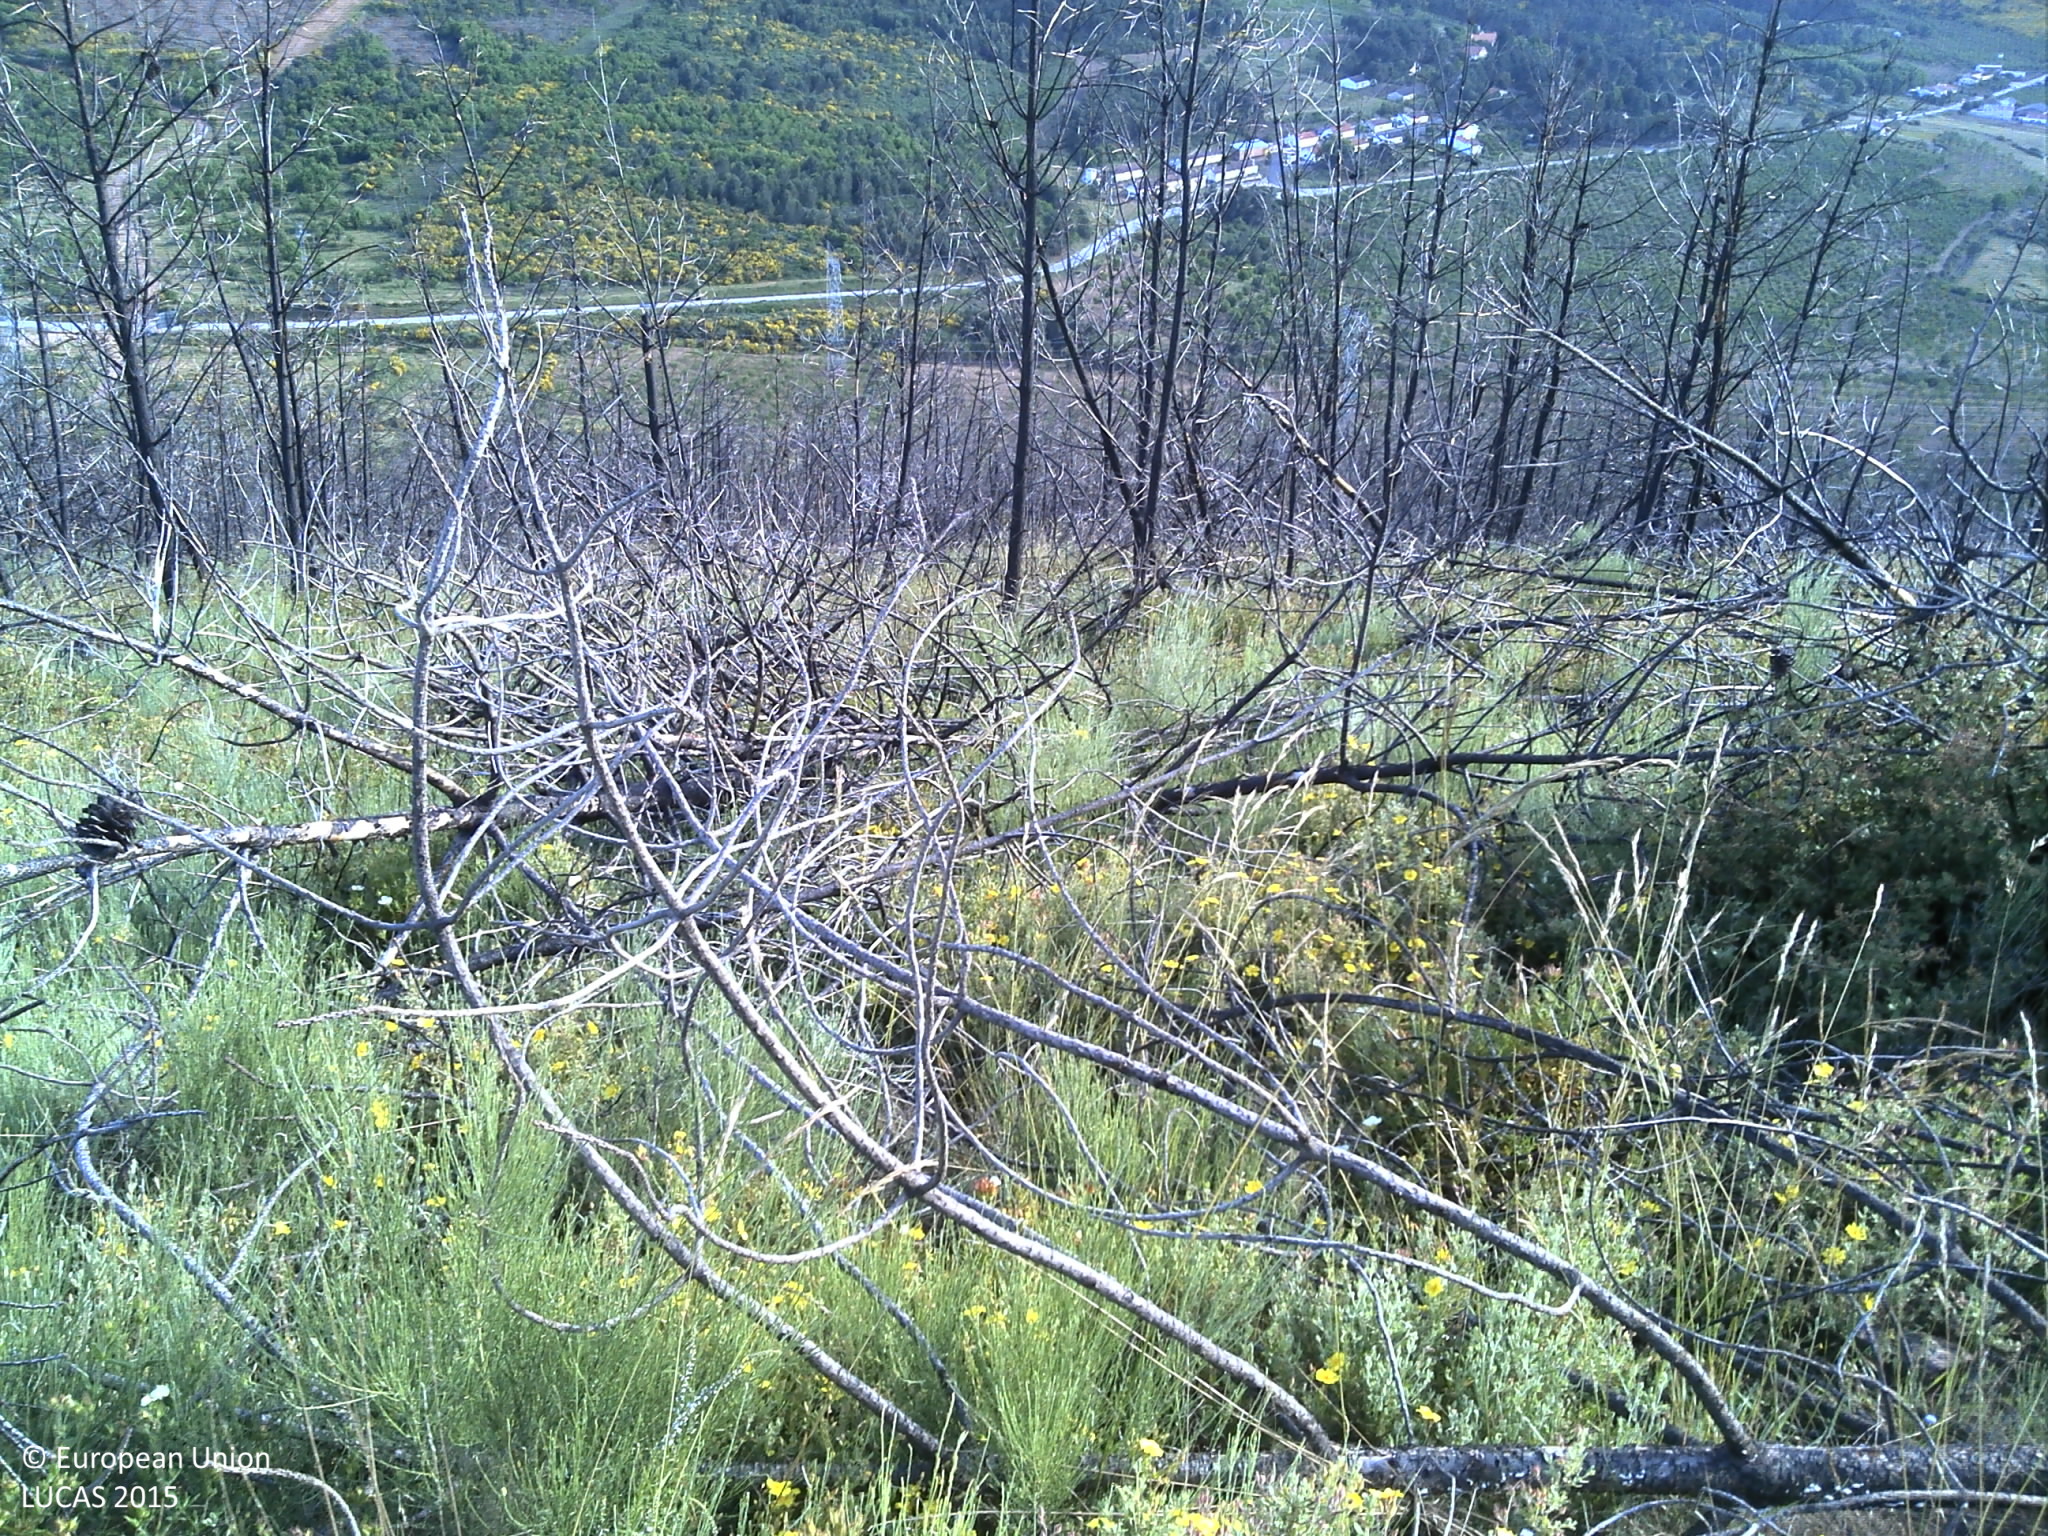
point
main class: Shrubland
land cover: Shrubland without tree cover
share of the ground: > 75 %
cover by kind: shrubs 90 %, herbaceous plants 10 %
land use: Forestry
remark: Burnt area
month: May
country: PT
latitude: 41.1936
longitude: -6.9566
